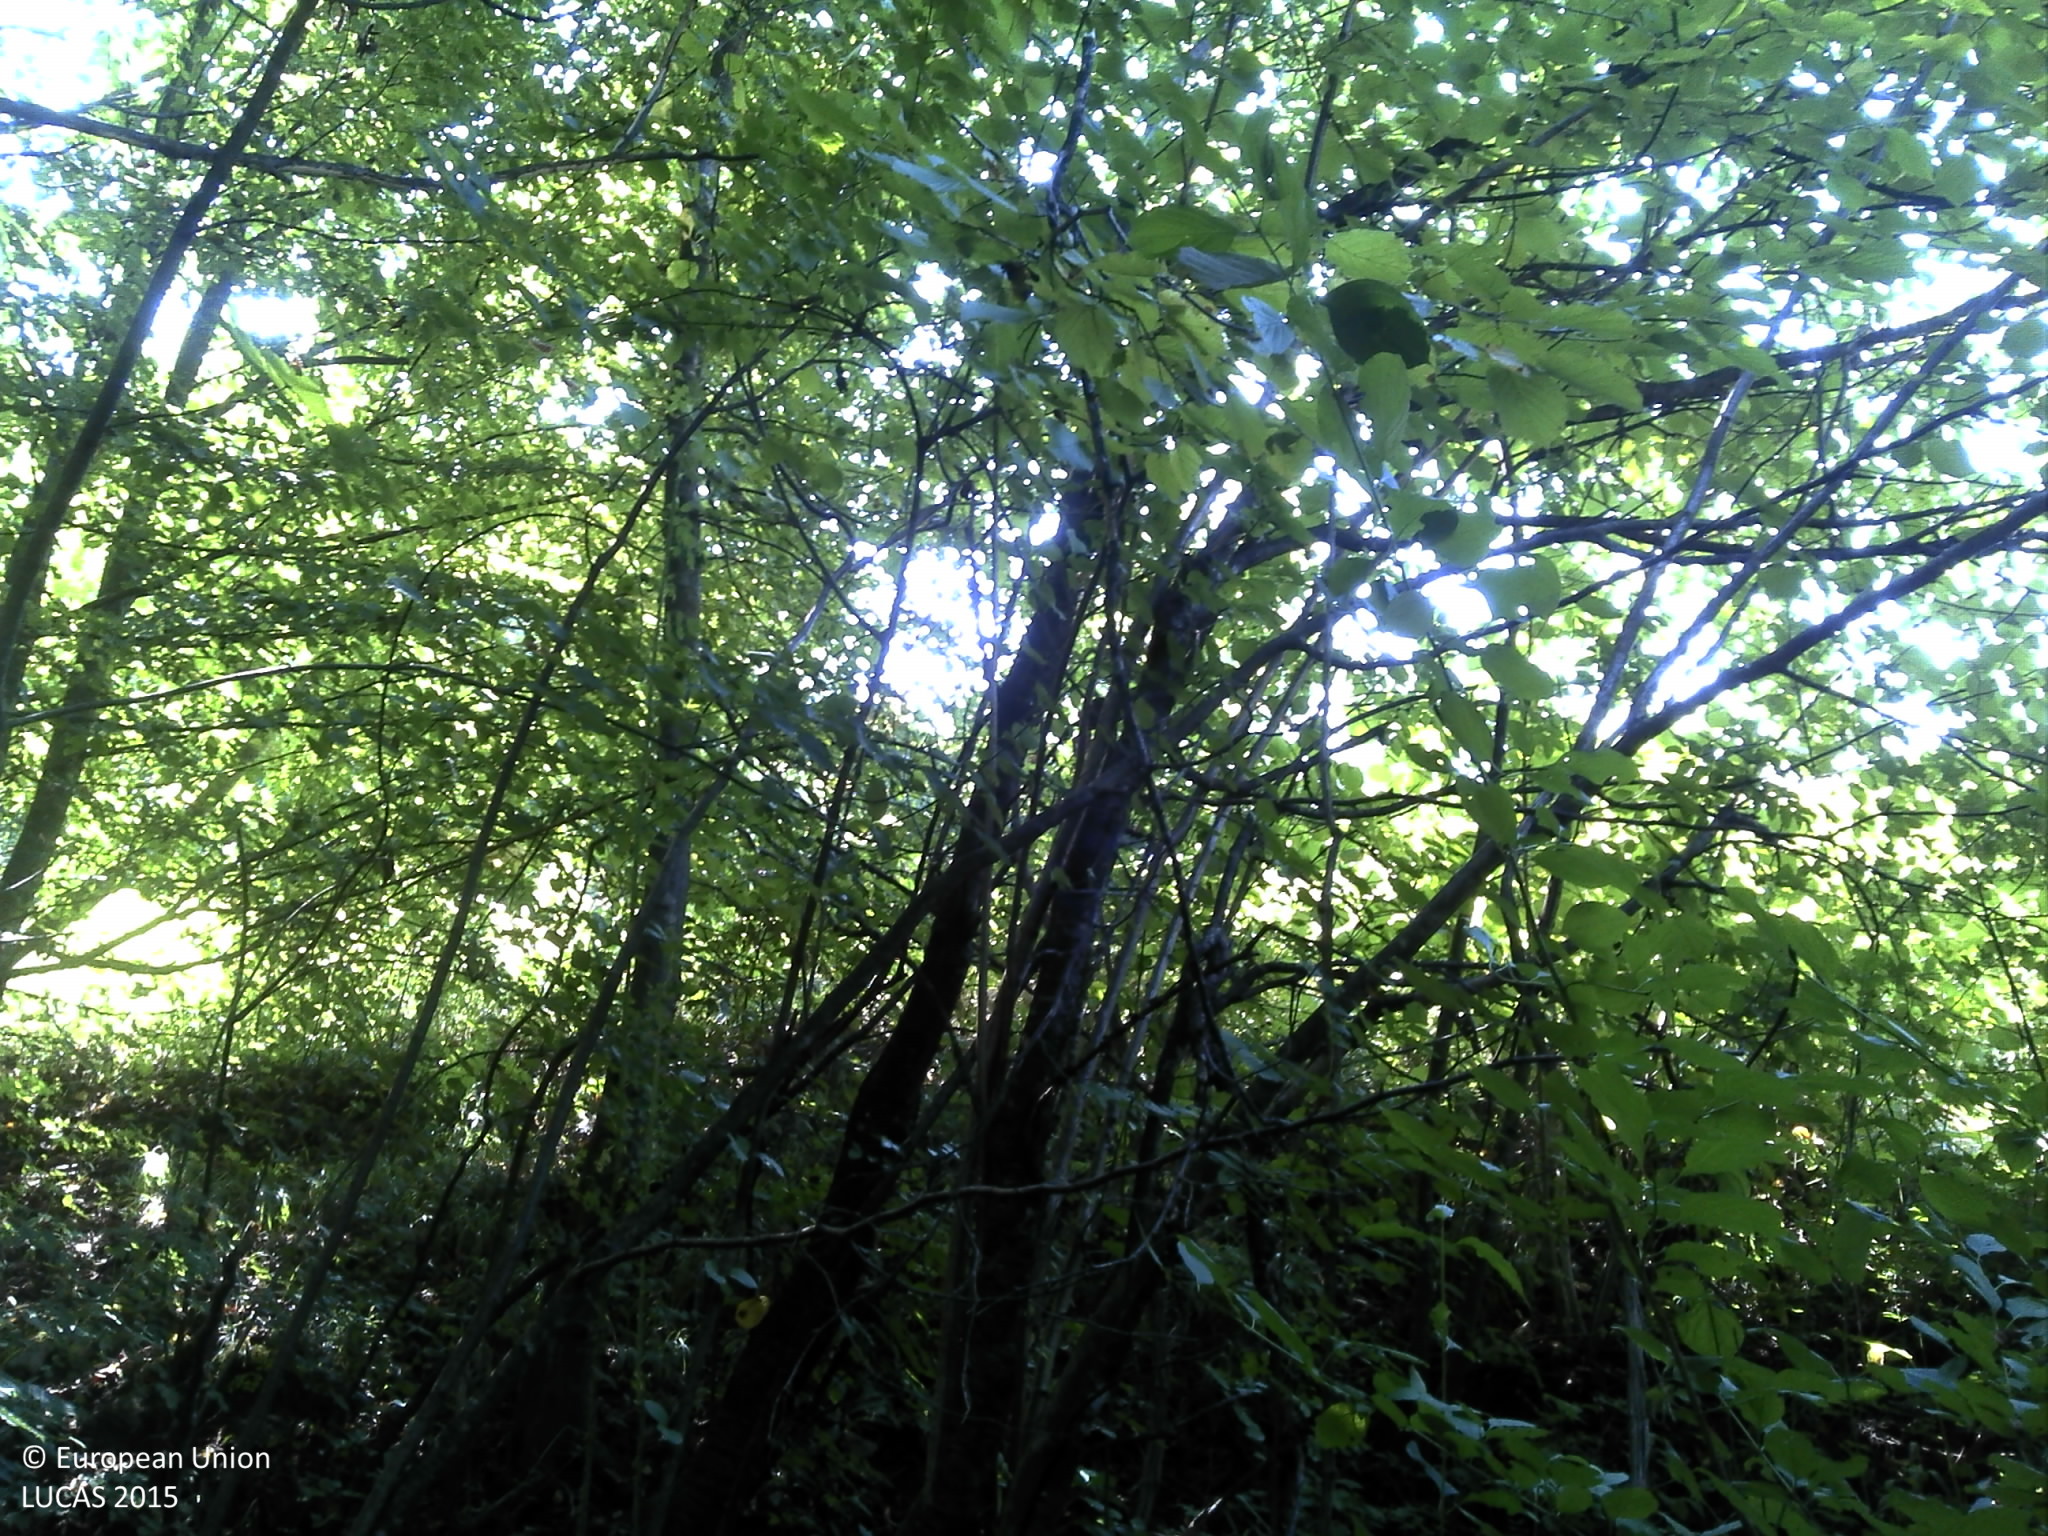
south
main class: Woodland
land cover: Broadleaved woodland
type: mesophytic deciduous forest
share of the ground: > 75 %
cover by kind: broadleaved forest trees 95 %, herbaceous plants 5 %
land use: Forestry
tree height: > 5 m
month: September
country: HR
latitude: 44.9371
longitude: 15.6592
